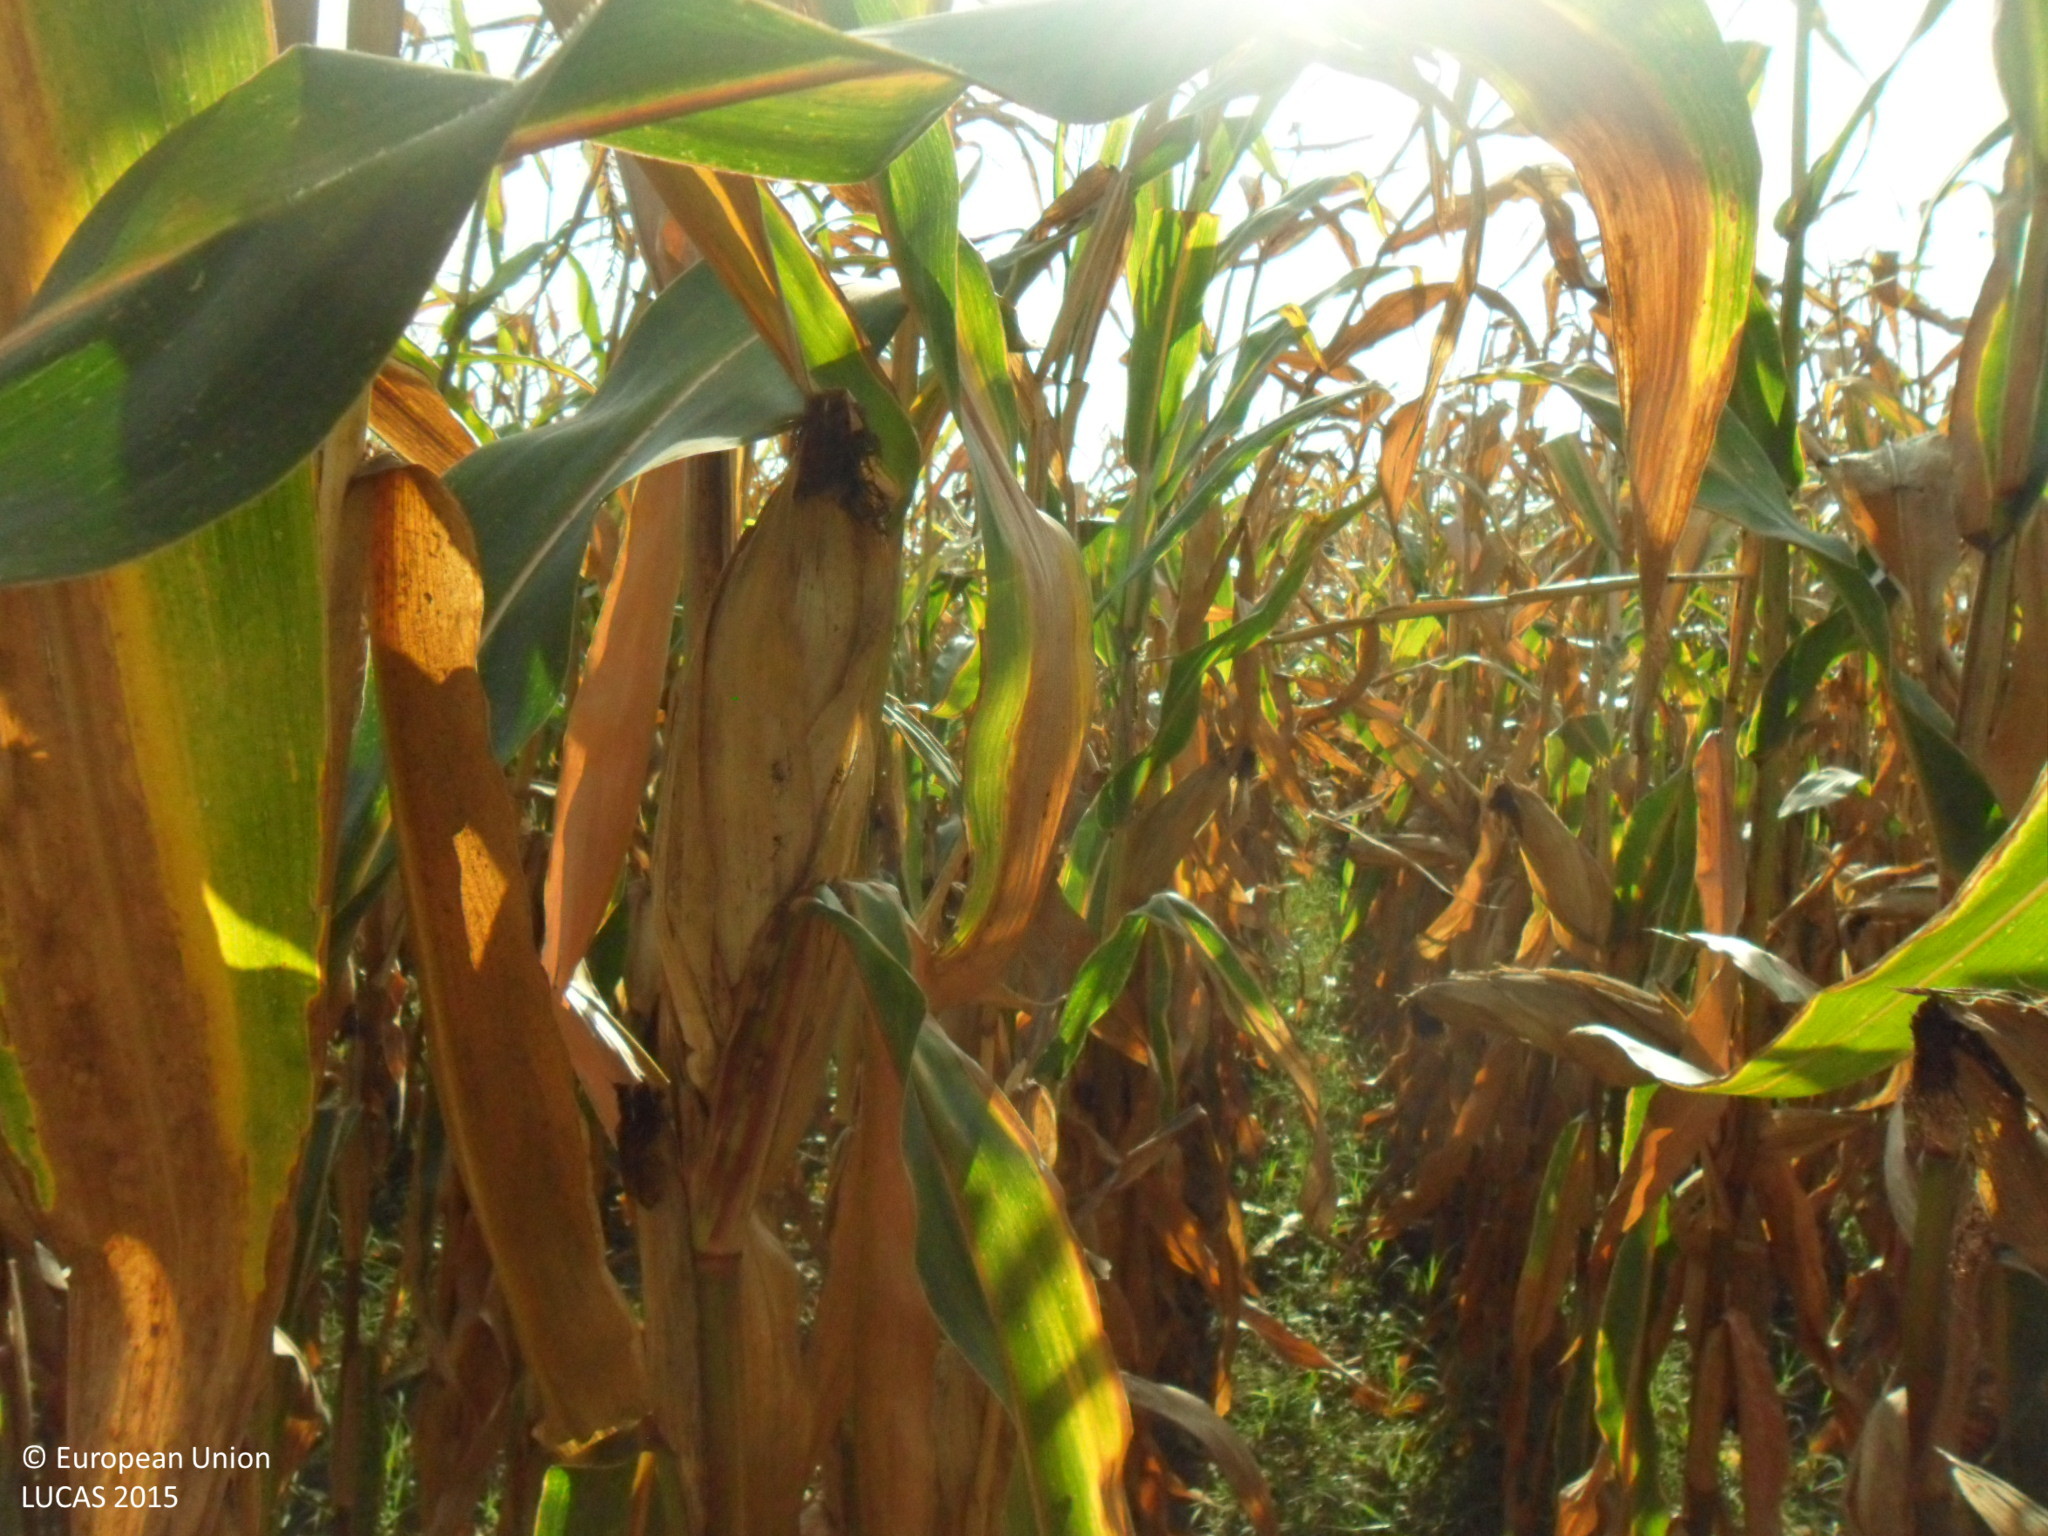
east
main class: Cropland
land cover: Maize
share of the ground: > 75 %
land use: Agriculture (excluding fallow land and kitchen gardens)
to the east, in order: Maize; Common wheat; Grassland without tree/shrub cover; Shruby margins; Ditches and canals; Shruby margins; Grassland without tree/shrub cover
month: September
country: BG
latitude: 43.6152
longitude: 26.2199
